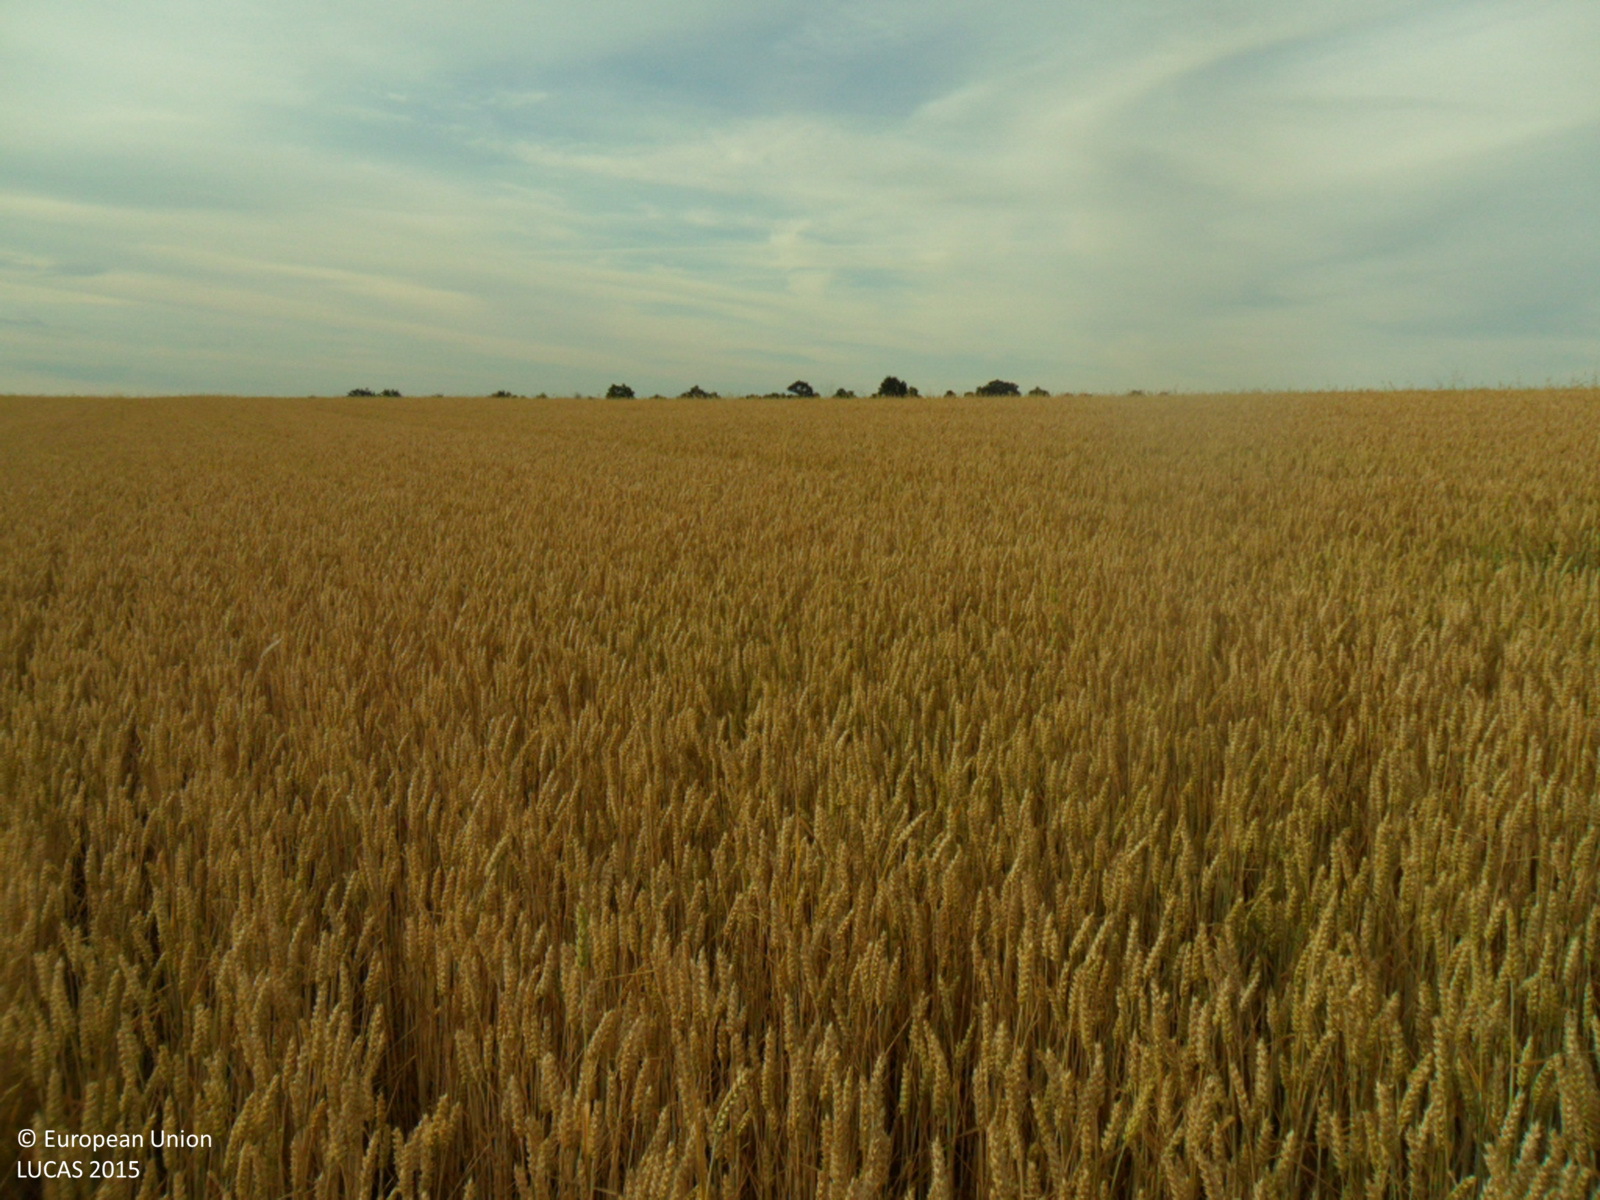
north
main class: Cropland
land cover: Common wheat
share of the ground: > 75 %
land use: Agriculture (excluding fallow land and kitchen gardens)
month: June
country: BG
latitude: 43.5795
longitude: 26.6668
